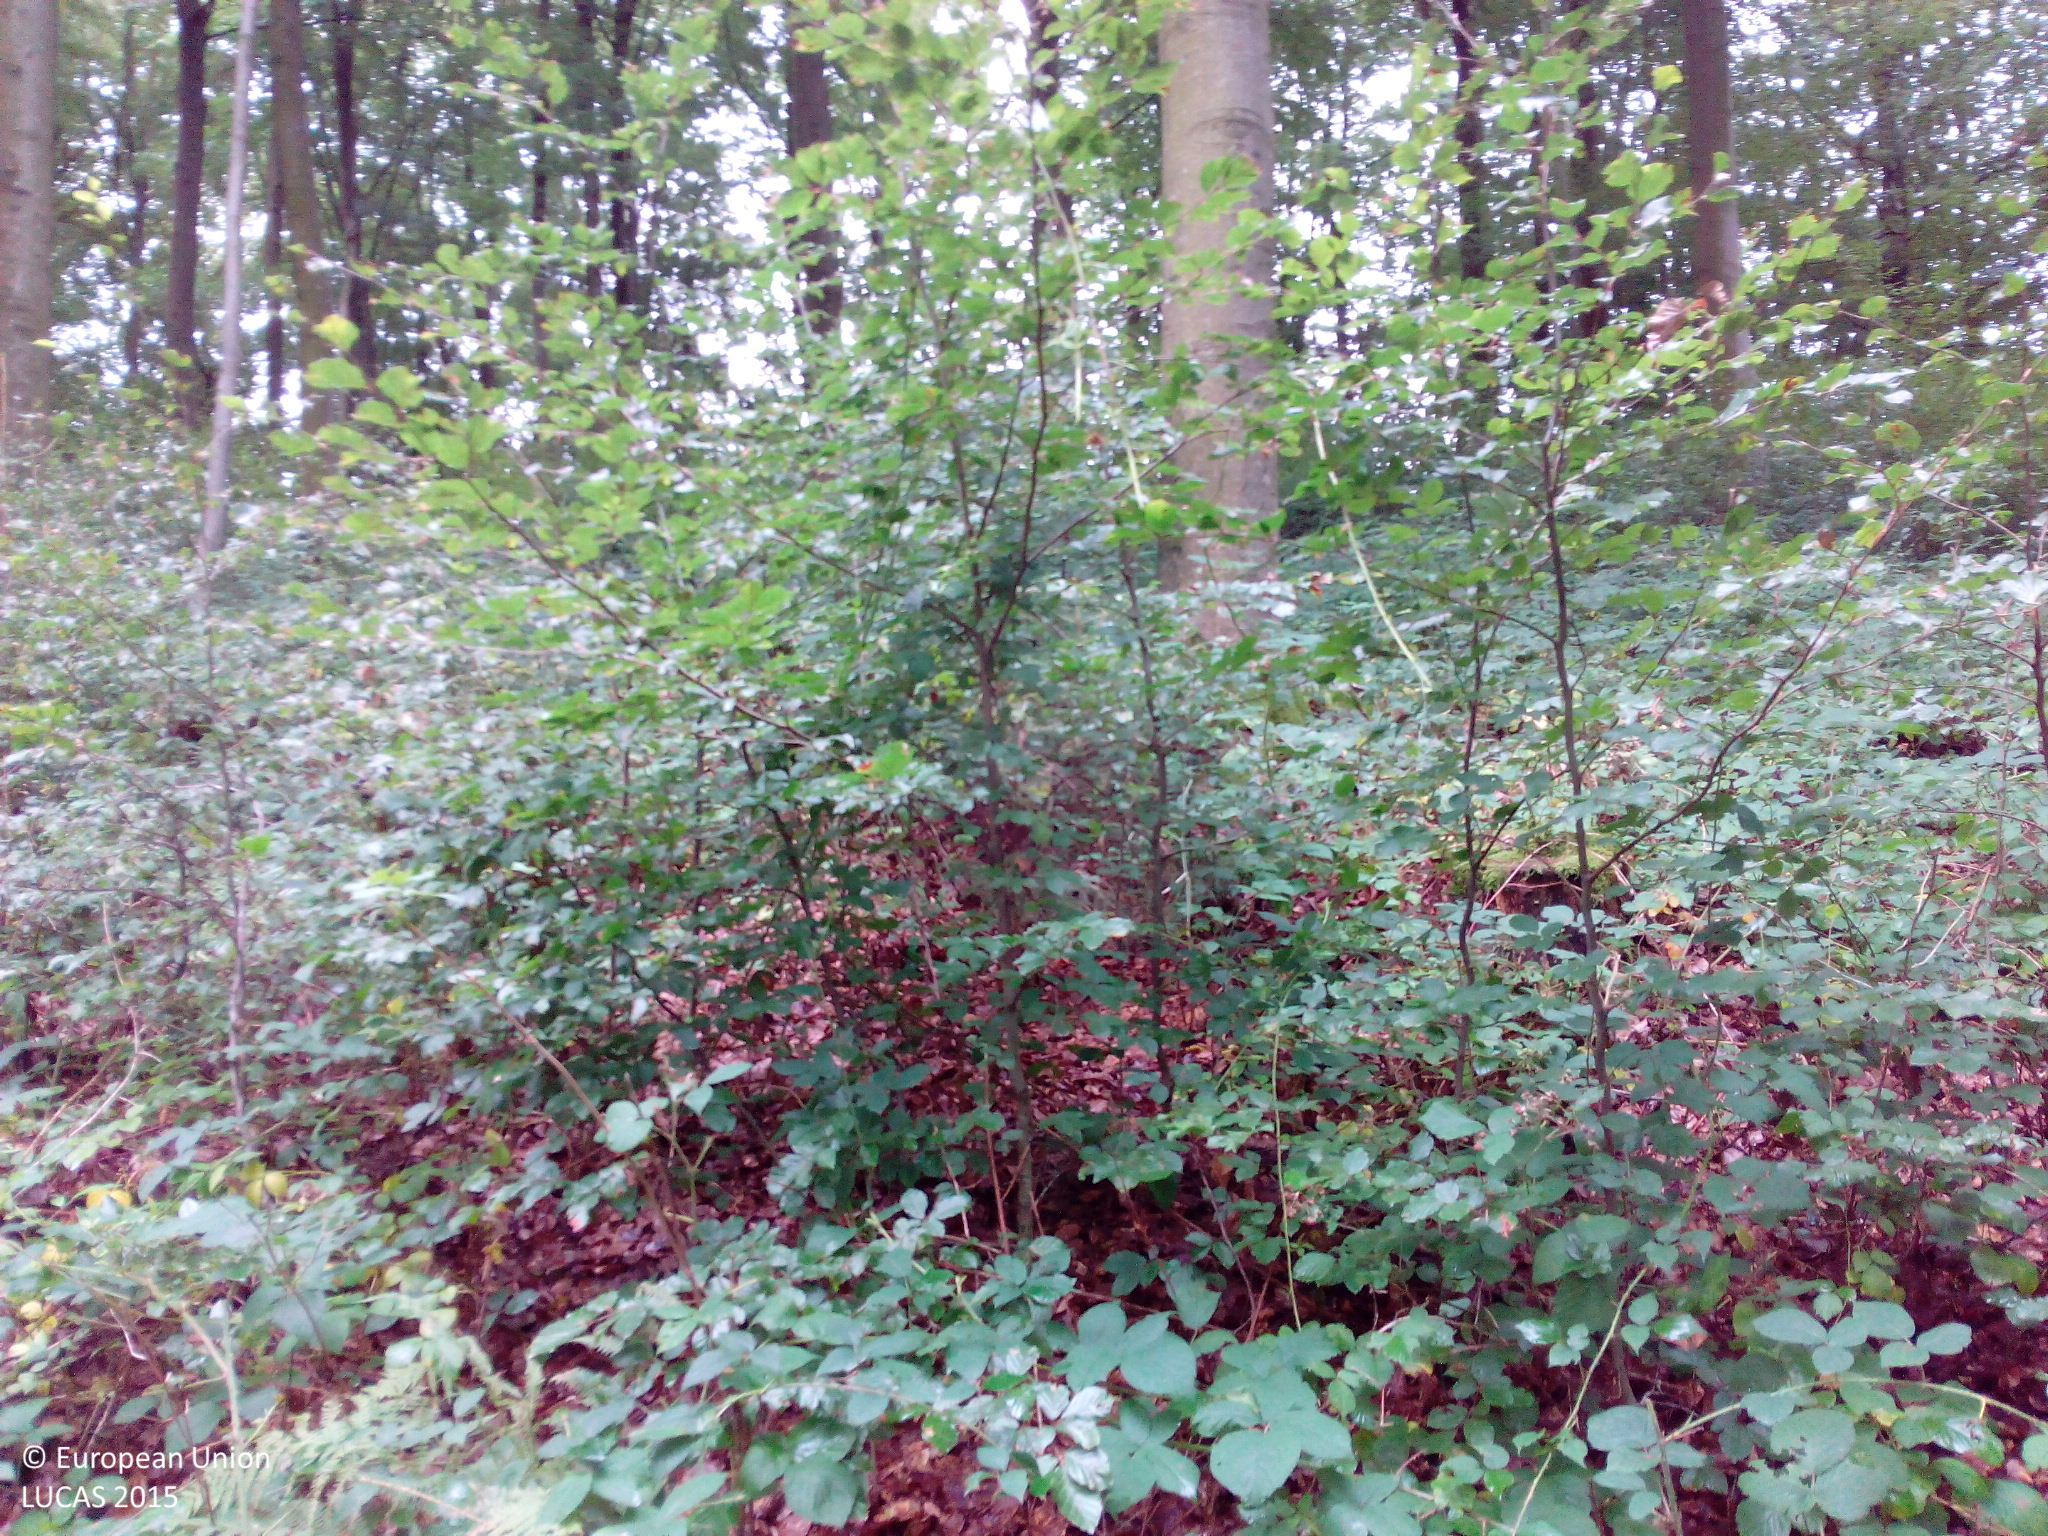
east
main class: Woodland
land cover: Broadleaved woodland
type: beech forest
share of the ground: > 75 %
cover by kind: broadleaved forest trees 100 %
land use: Forestry
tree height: > 5 m
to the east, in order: Broadleaved woodland; Tracks; Broadleaved woodland; Fences; Grassland without tree/shrub cover; Fences; Maize; Barley
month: August
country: DE
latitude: 50.0163
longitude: 6.3012
